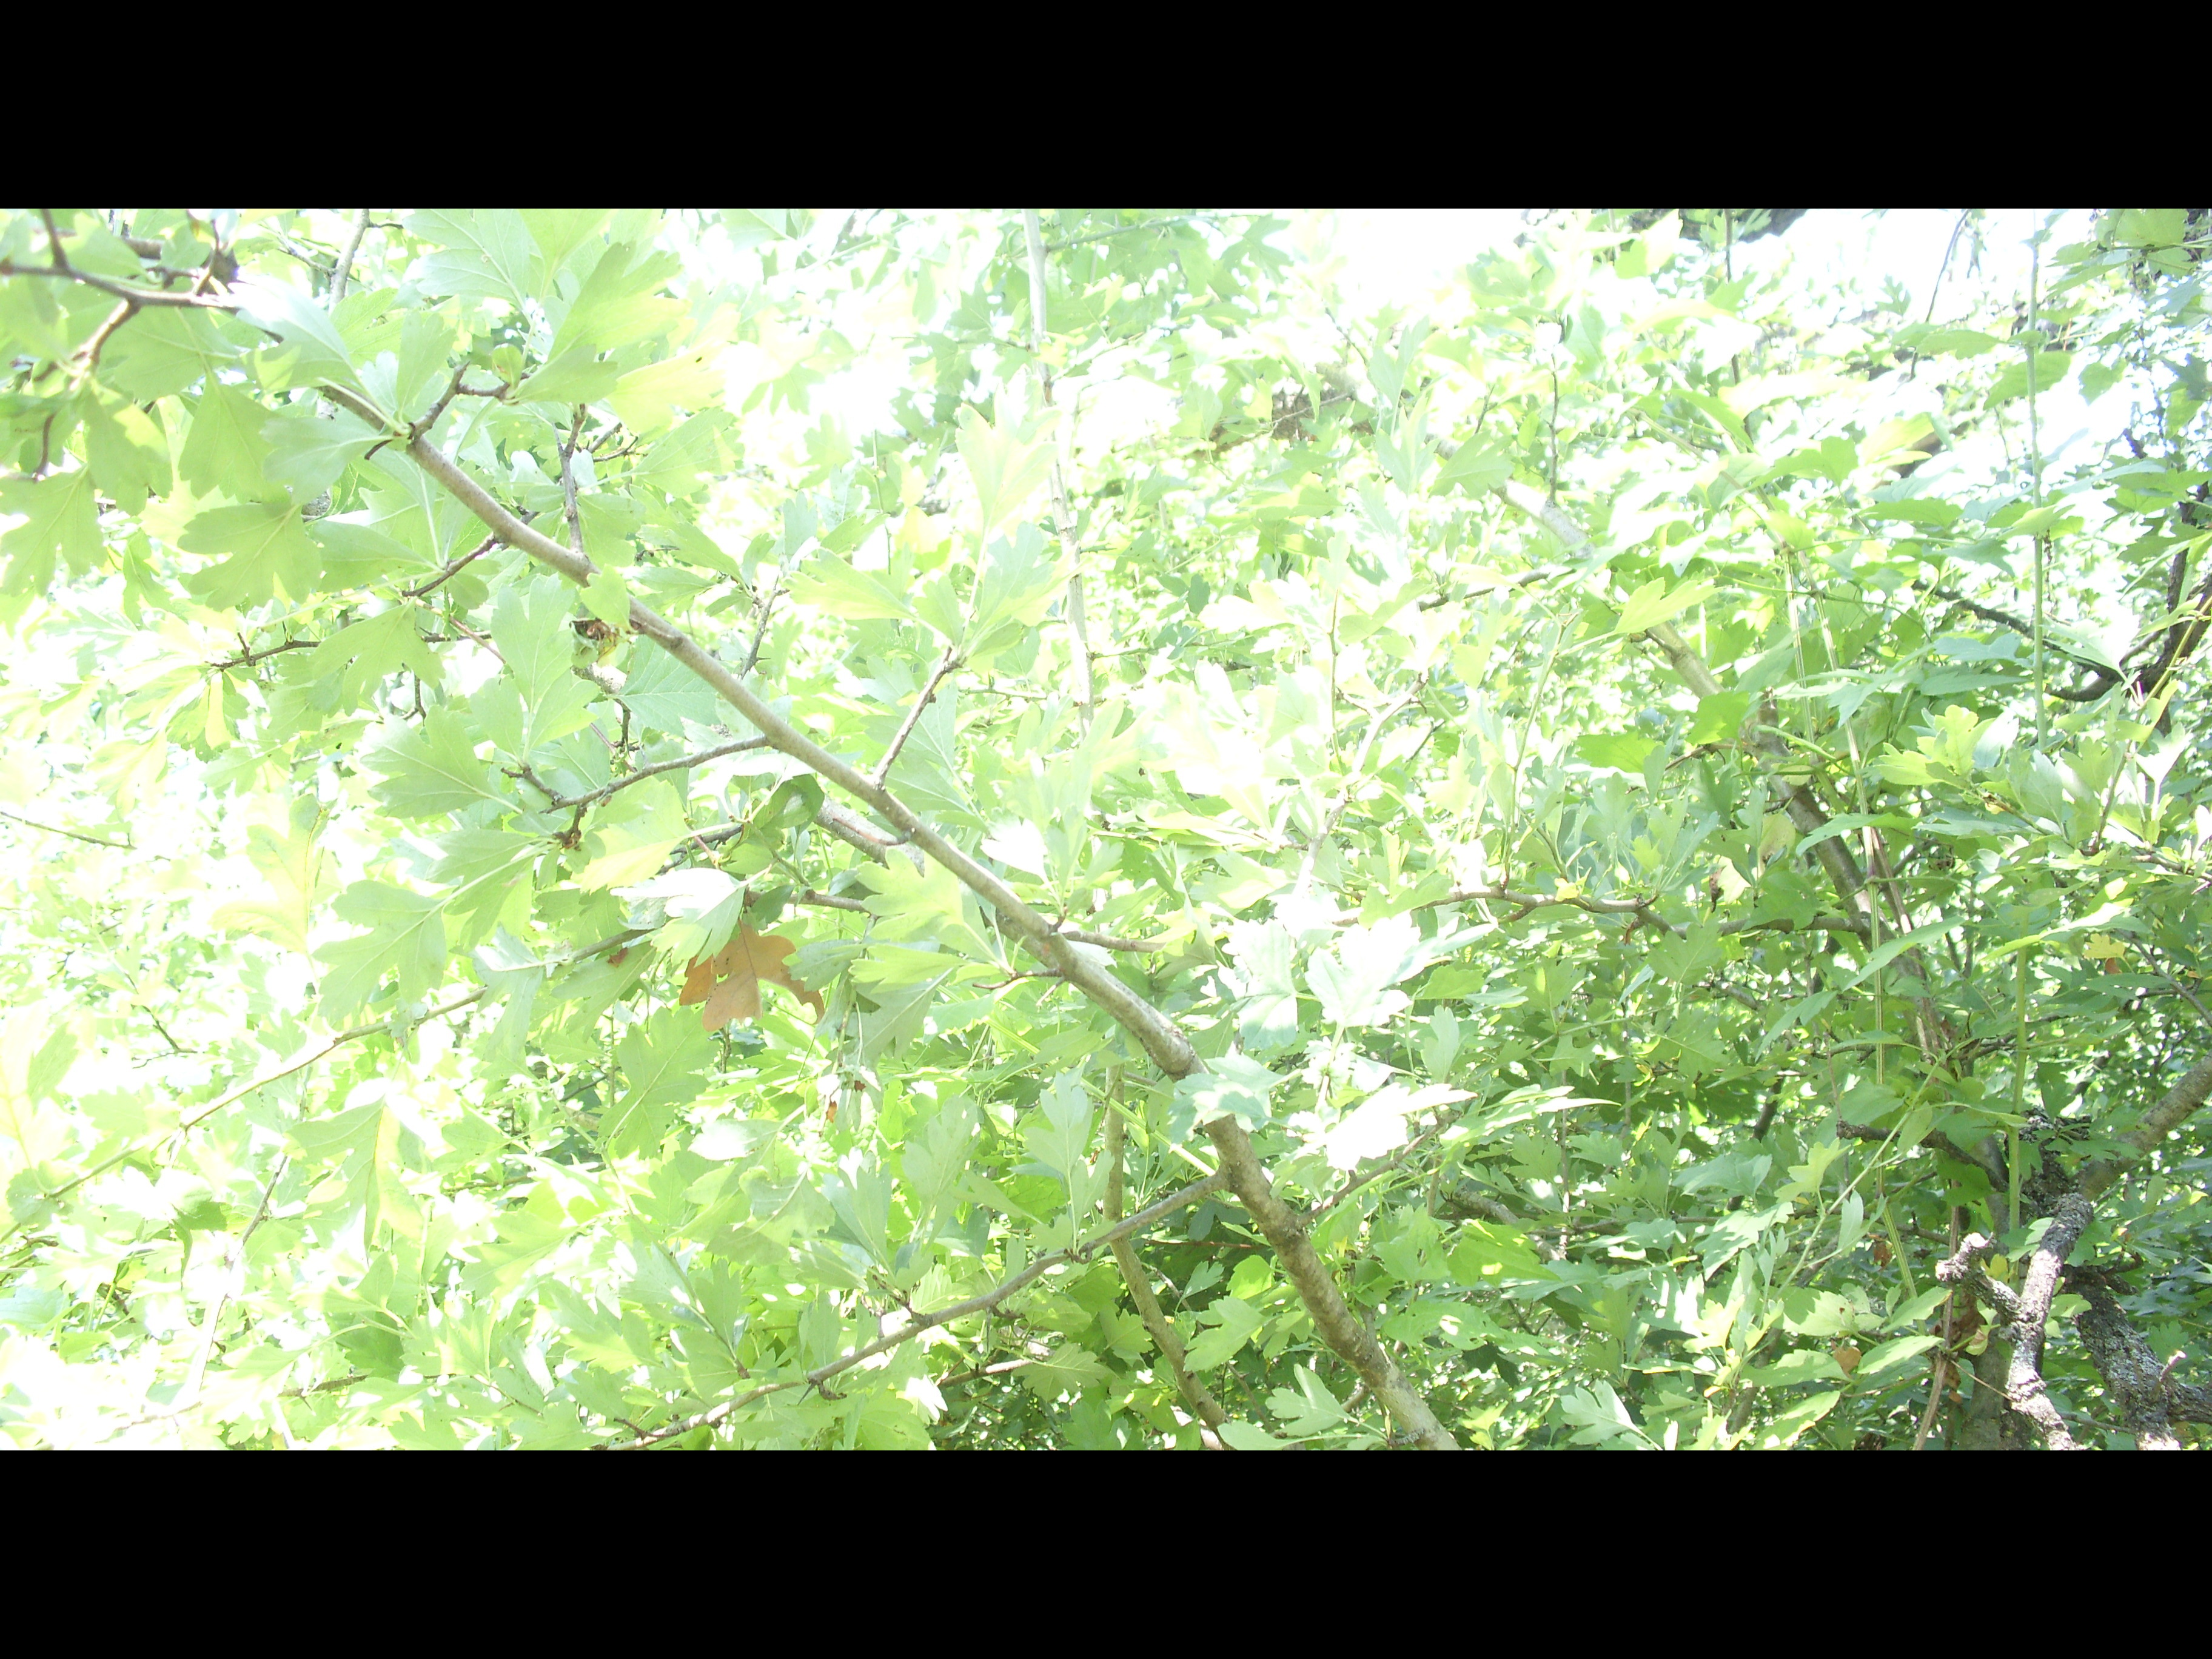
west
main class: Woodland
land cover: Broadleaved woodland
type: mesophytic deciduous forest
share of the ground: > 75 %
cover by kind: broadleaved forest trees 95 %, shrubs 5 %
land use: Forestry
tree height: > 5 m
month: June
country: BG
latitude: 43.5886
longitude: 23.6597
